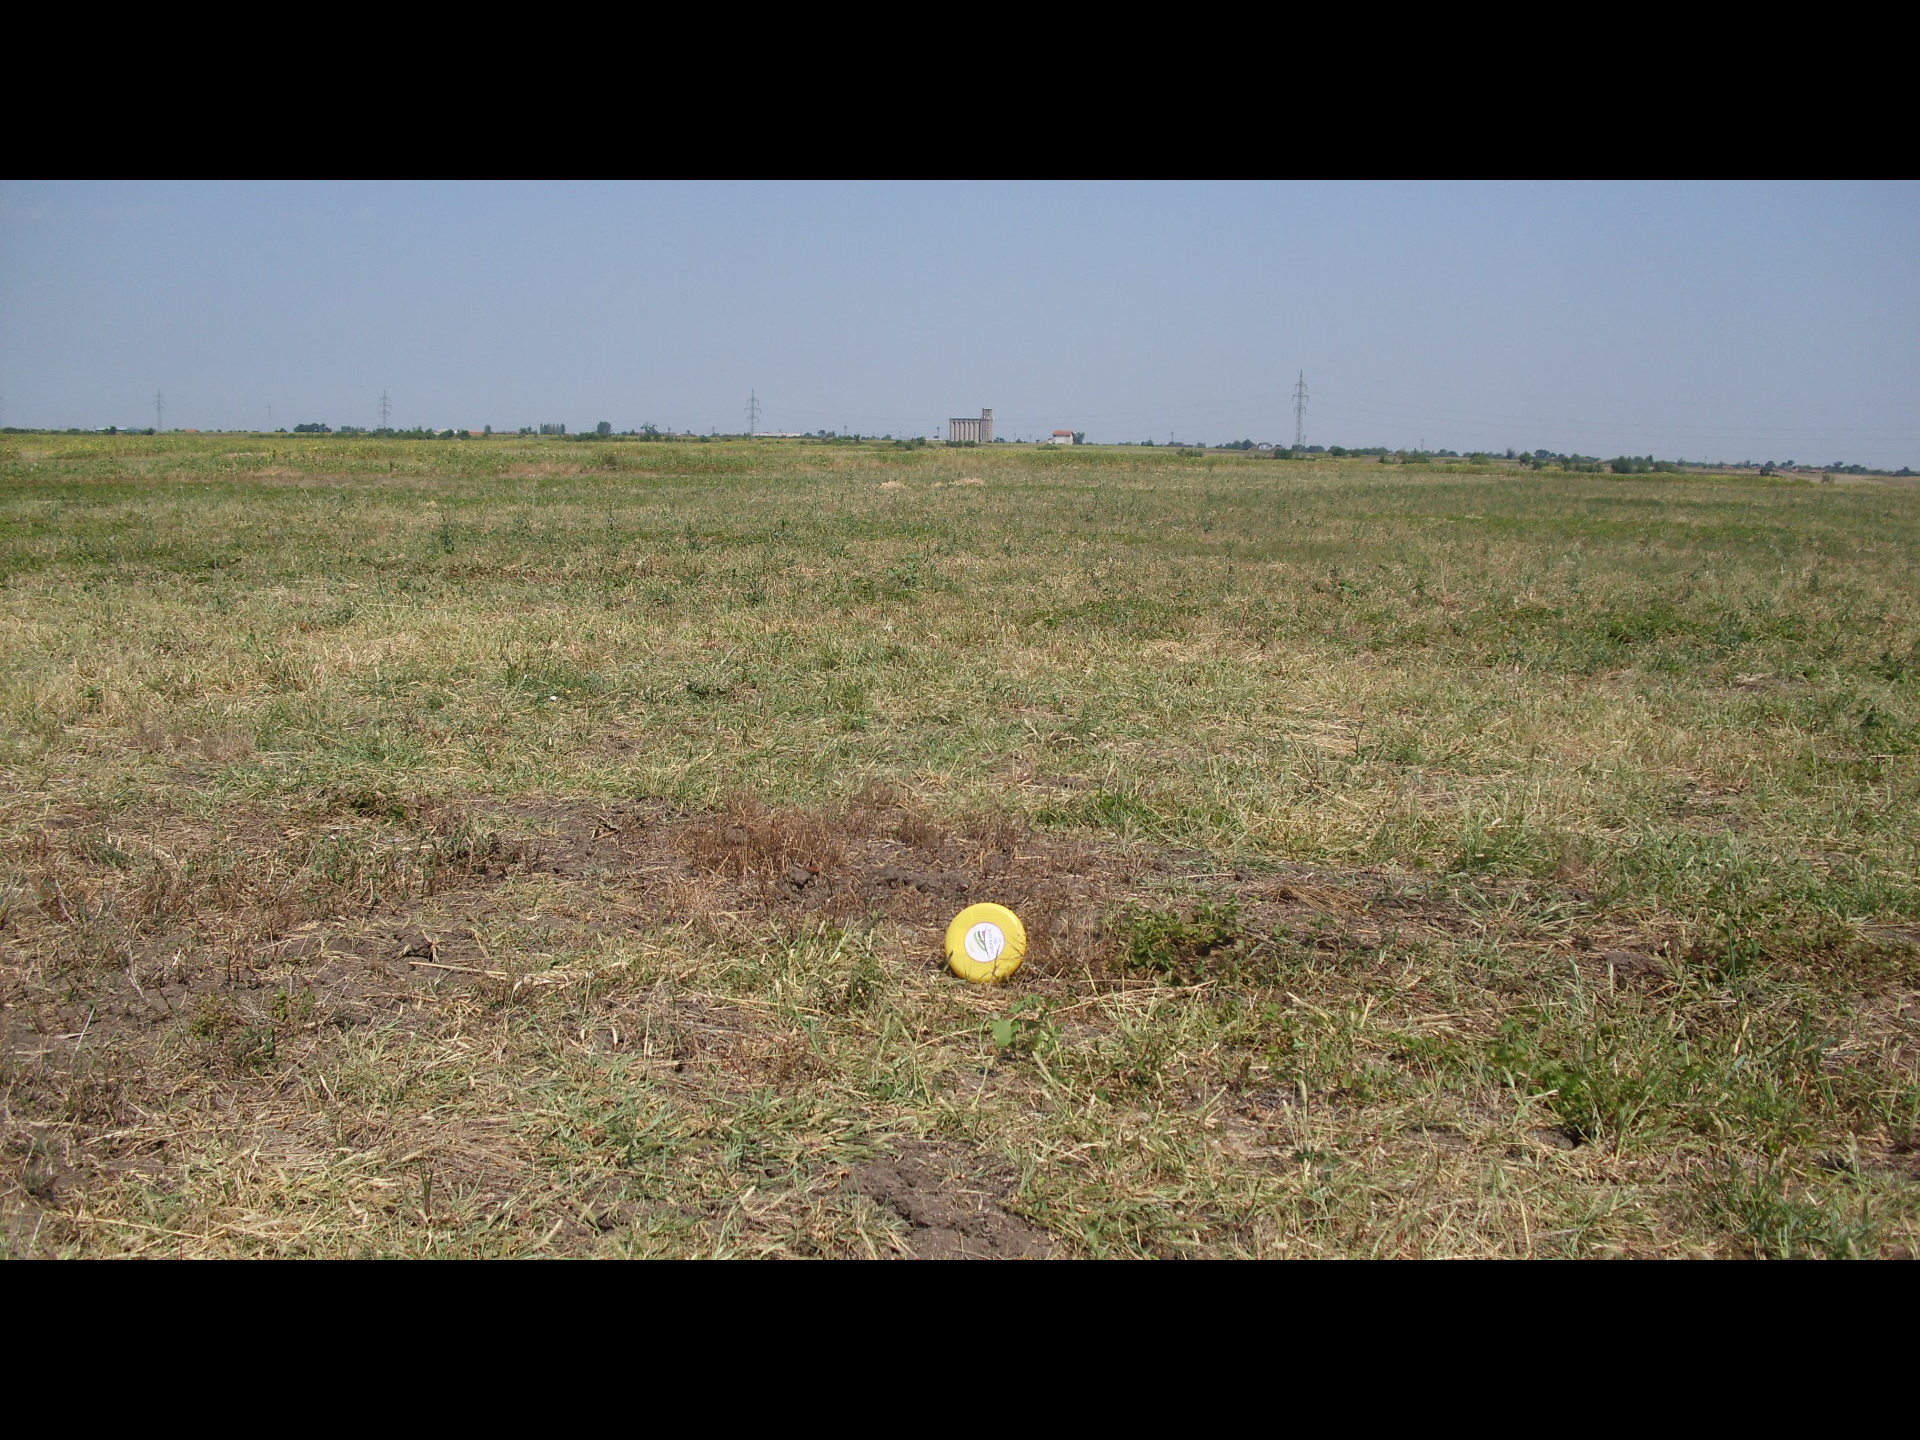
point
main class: Grassland
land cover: Spontaneously vegetated surfaces
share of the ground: > 75 %
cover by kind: herbaceous plants 100 %
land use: Agriculture (excluding fallow land and kitchen gardens)
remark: Harvested field
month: July
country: BG
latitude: 43.5997
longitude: 23.1591
